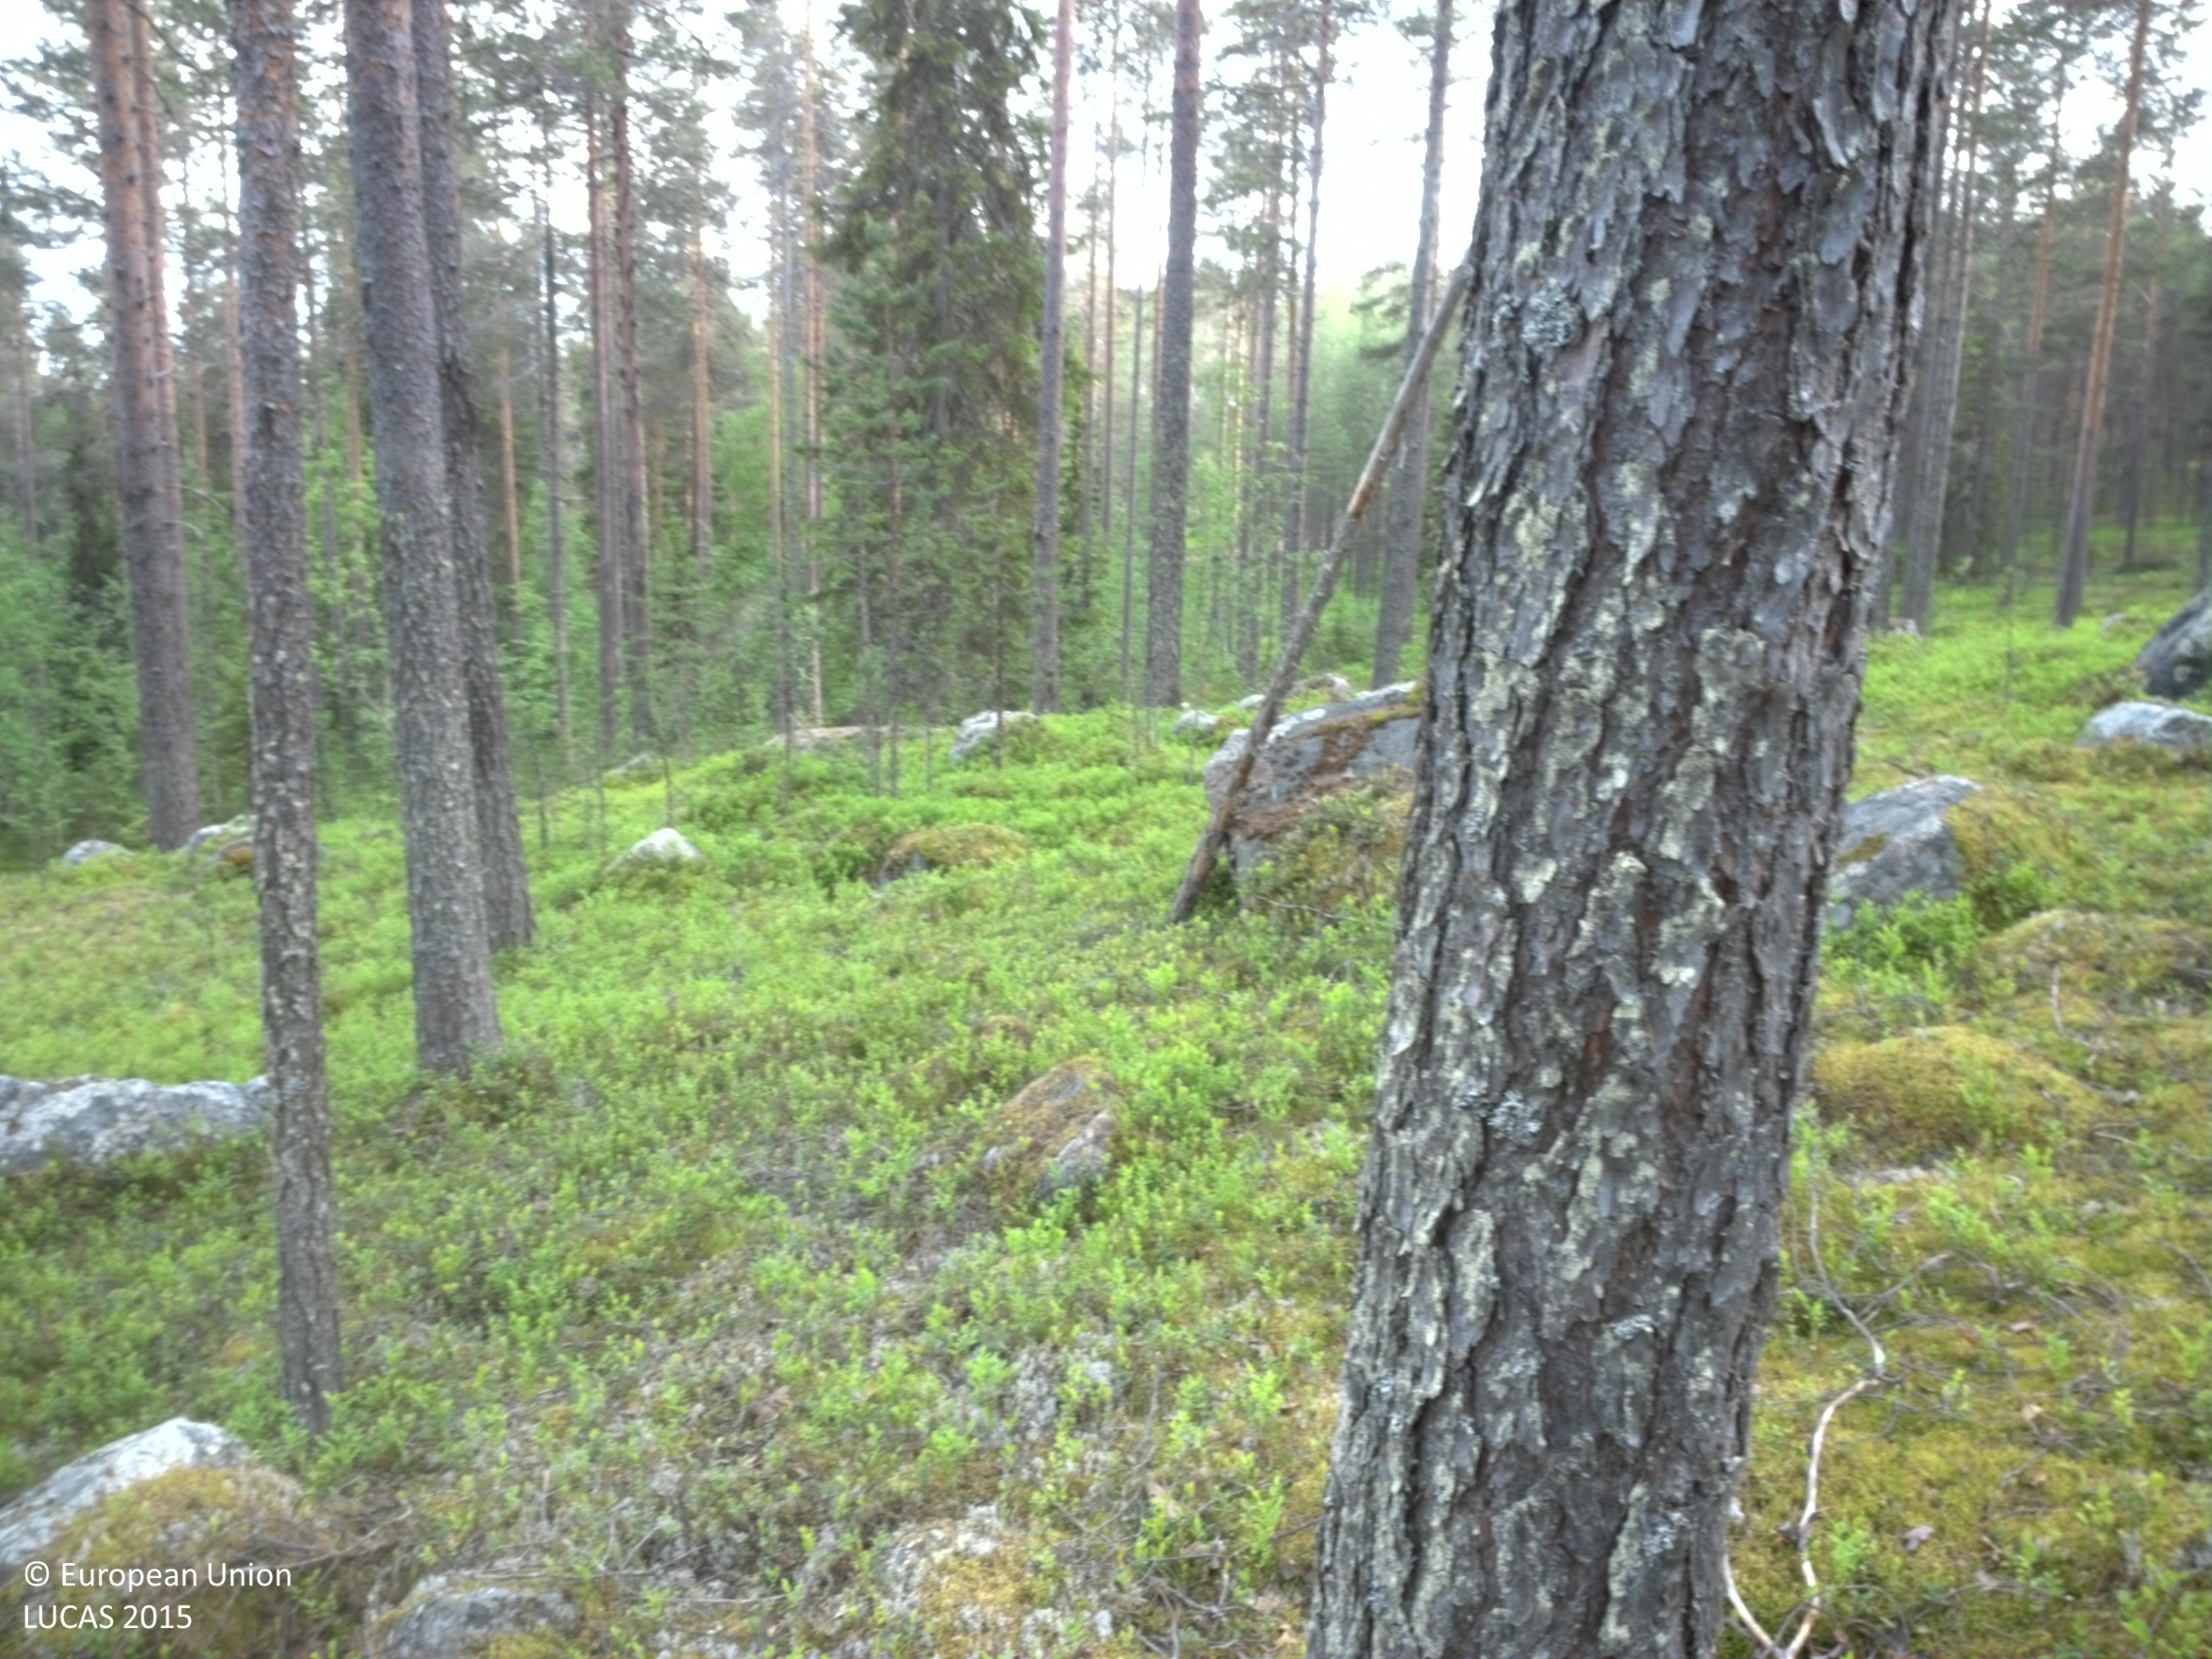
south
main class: Woodland
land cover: Pine dominated coniferous woodland
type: boreal forest
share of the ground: 25 - 50 %
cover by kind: shrubs 50 %, coniferous forest trees 40 %, consolidated bare surface 10 %
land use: Forestry
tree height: > 5 m
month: June
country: SE
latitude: 66.3019
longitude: 22.7985
